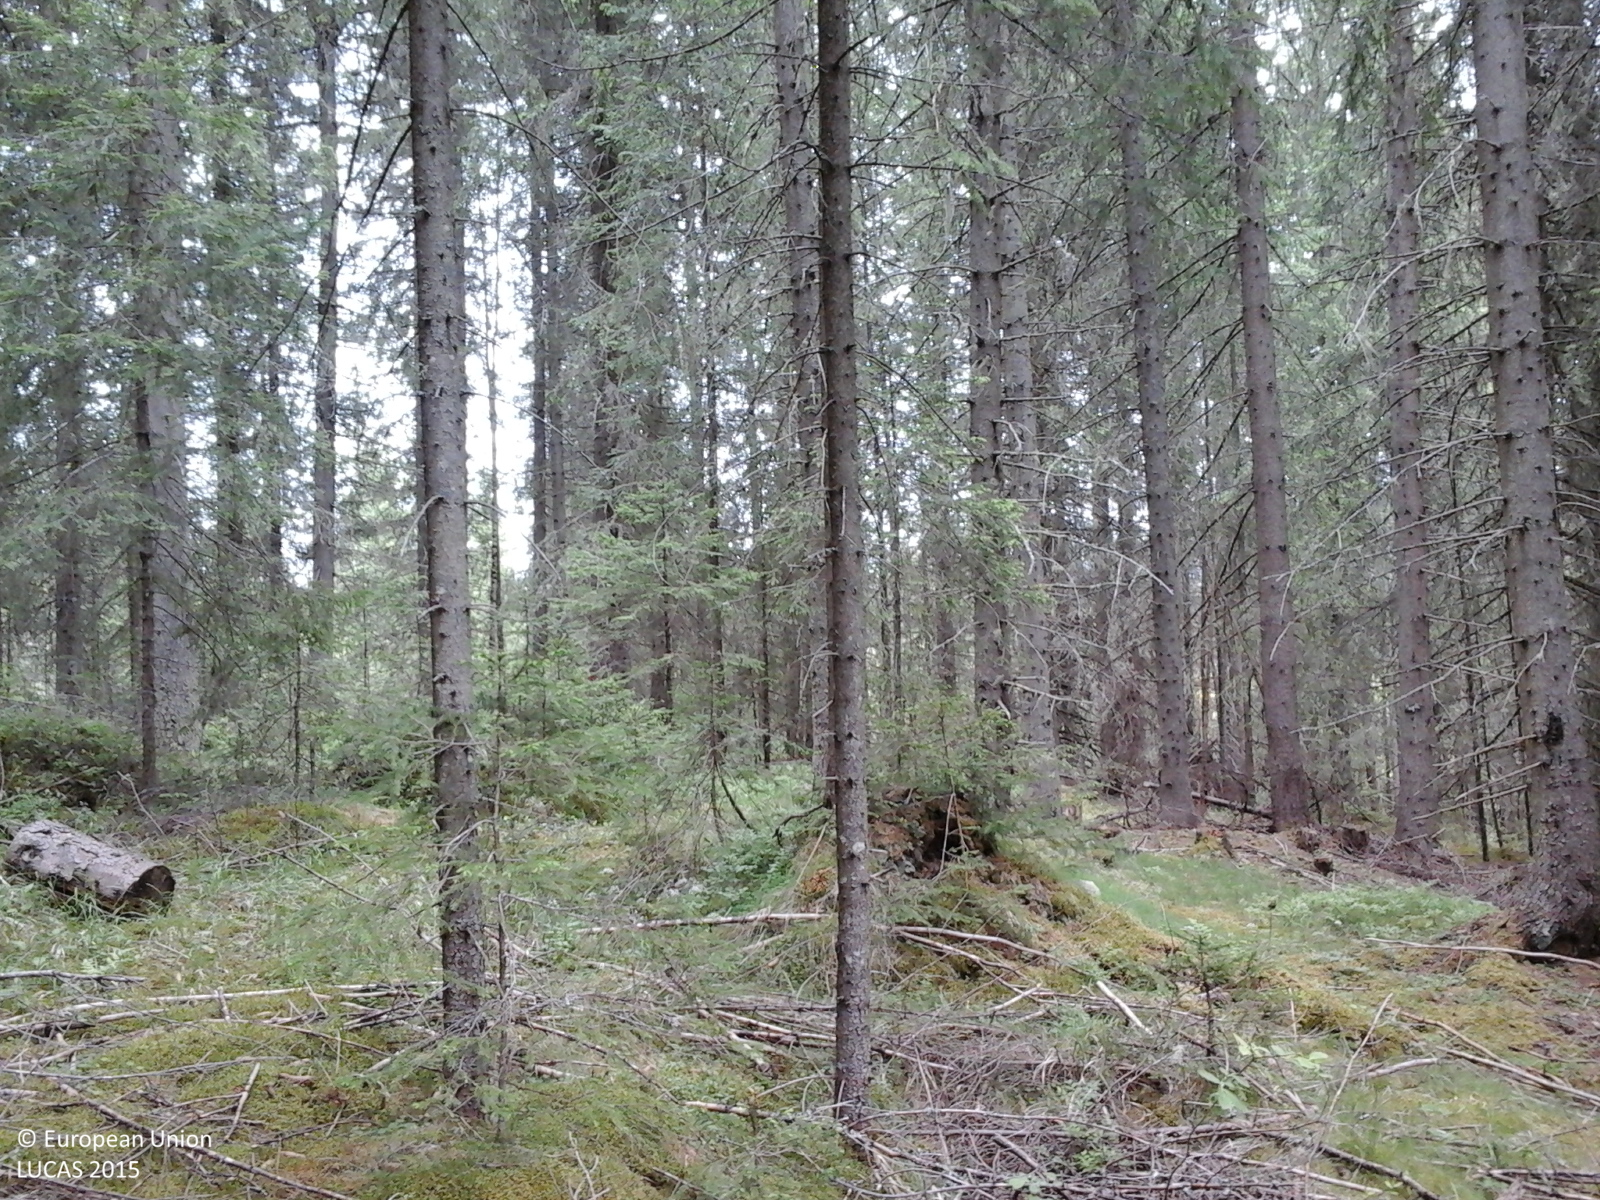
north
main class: Woodland
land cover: Spruce dominated coniferous woodland
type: alpine coniferous forest
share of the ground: > 75 %
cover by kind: coniferous forest trees 100 %
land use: Forestry
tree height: > 5 m
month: June
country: RO
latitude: 47.1480
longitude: 25.4225
